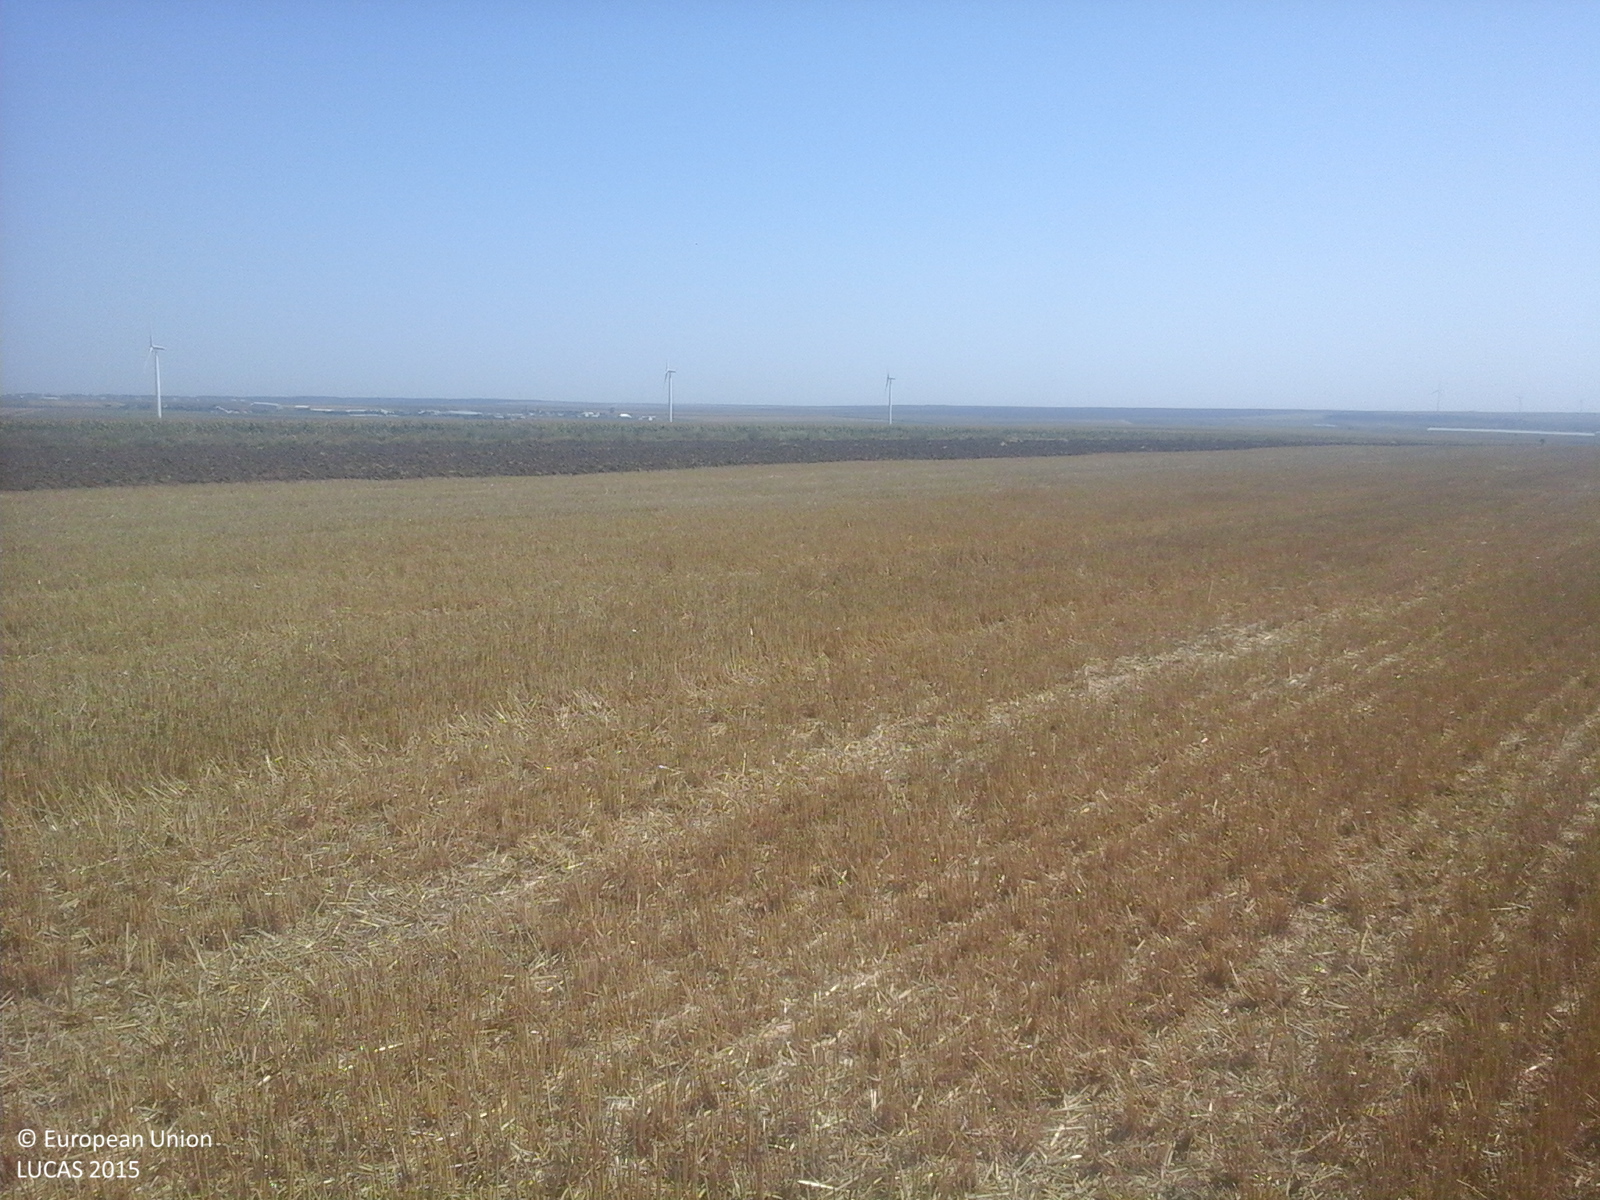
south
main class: Cropland
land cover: Common wheat
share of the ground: > 75 %
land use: Agriculture (excluding fallow land and kitchen gardens)
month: August
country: RO
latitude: 44.4240
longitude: 28.3950
